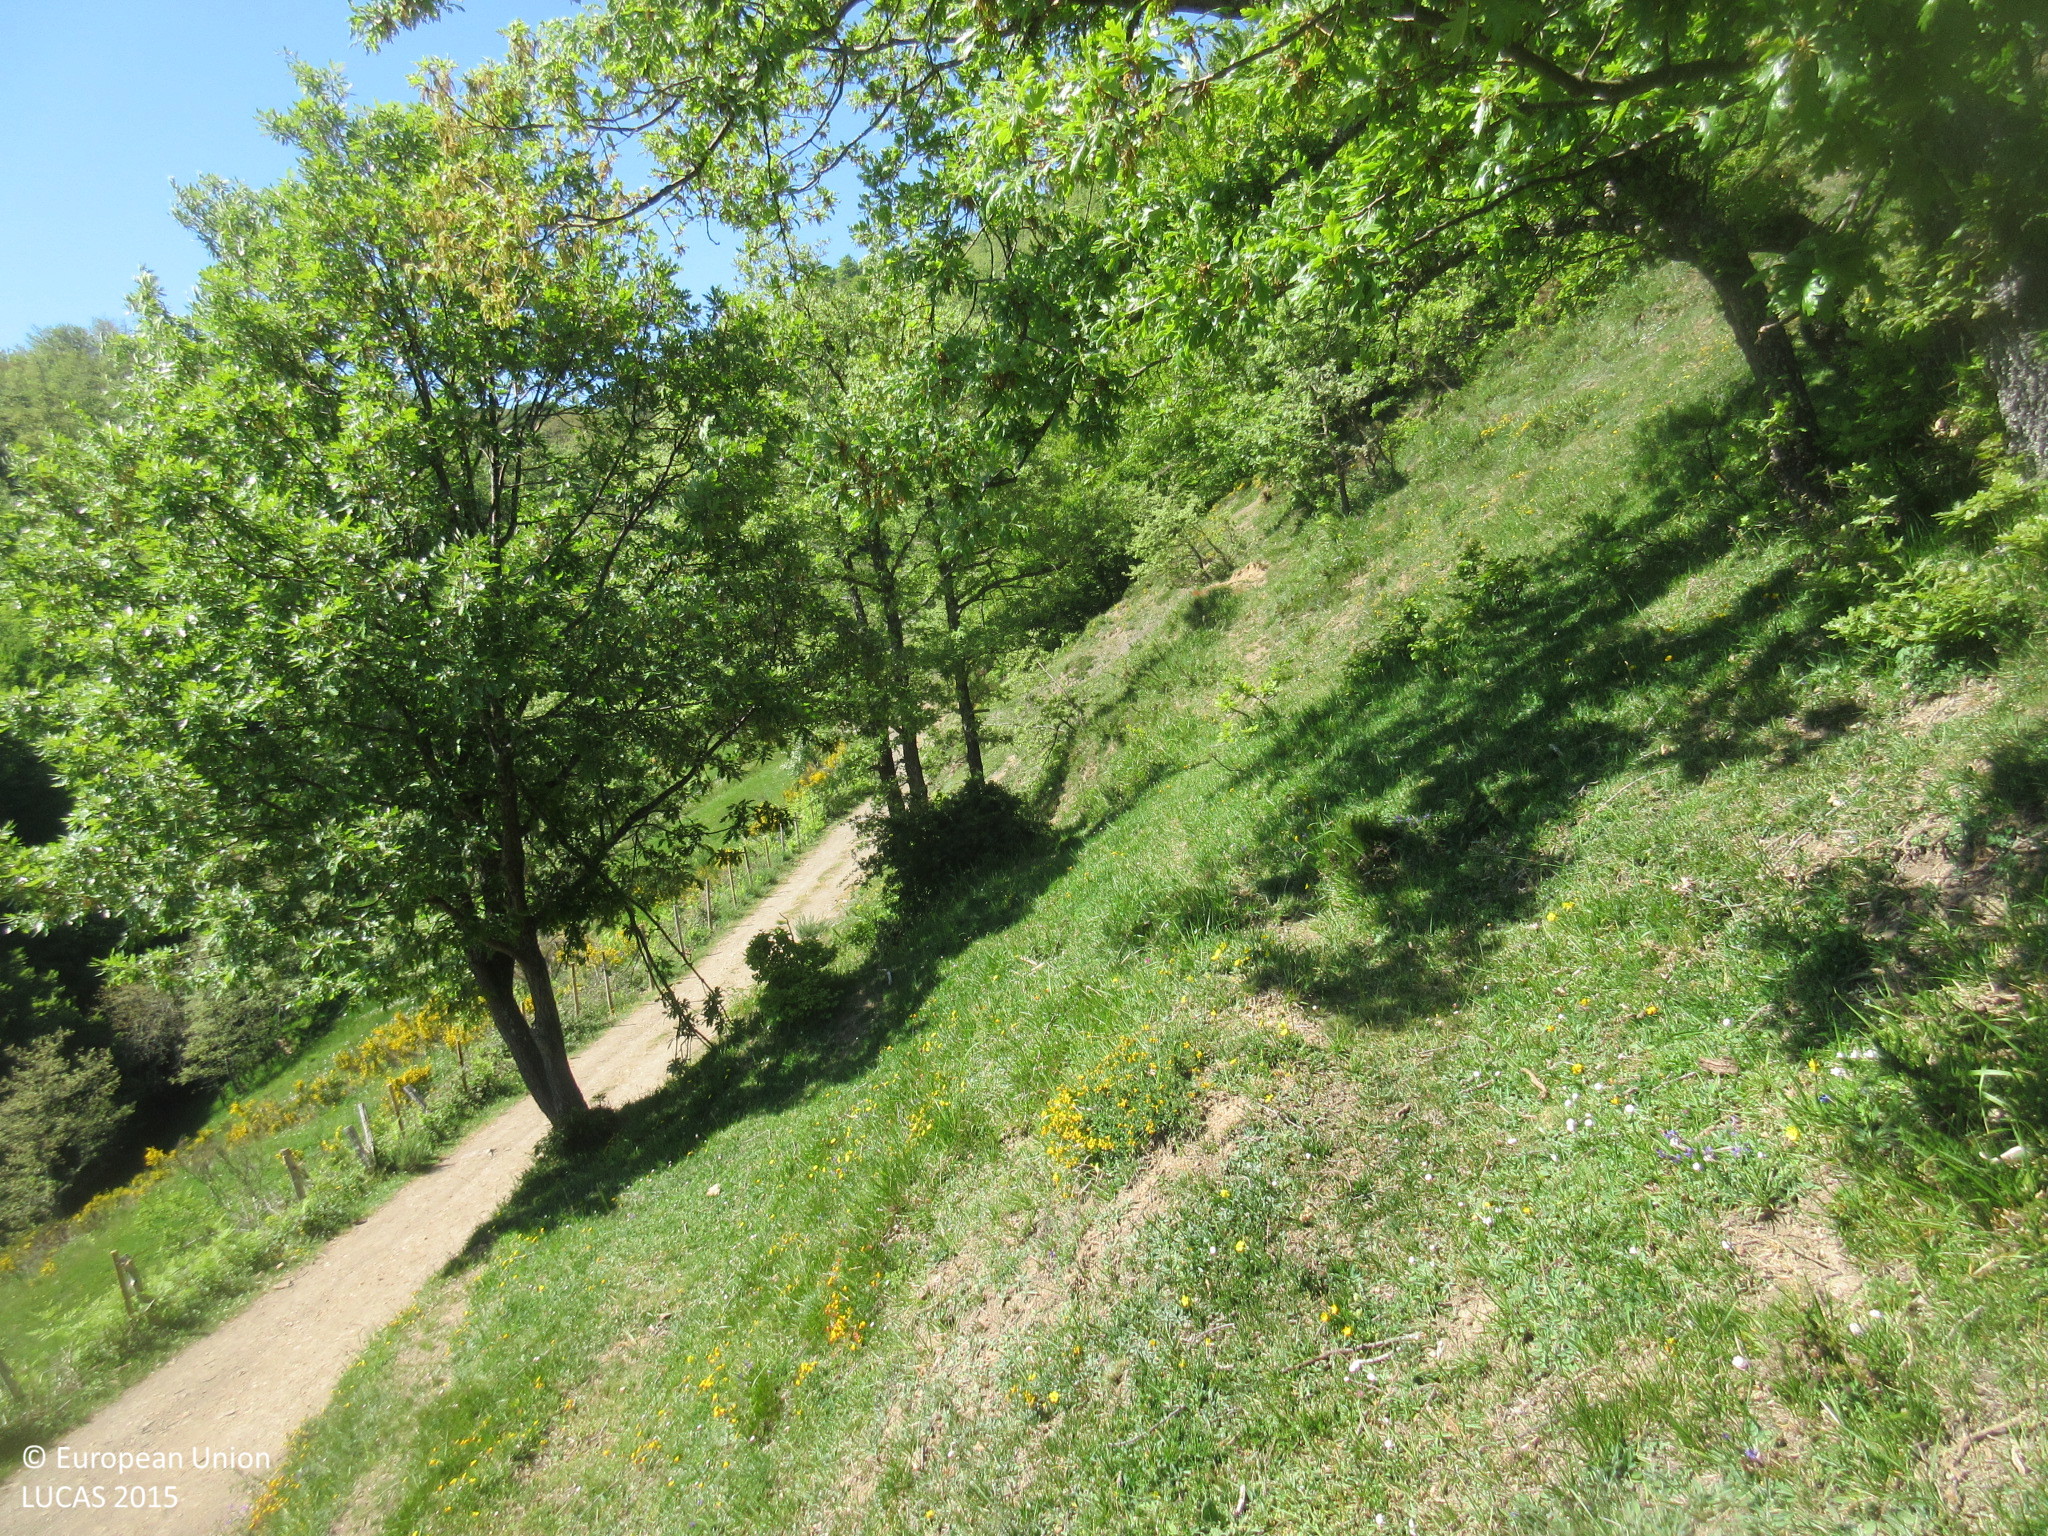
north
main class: Woodland
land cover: Broadleaved woodland
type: acidophilous oak and oak-birch forest
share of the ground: > 75 %
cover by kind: broadleaved forest trees 80 %, shrubs 10 %, herbaceous plants 10 %
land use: Agriculture (excluding fallow land and kitchen gardens)
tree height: > 5 m
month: June
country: ES
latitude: 43.0925
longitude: -4.4674
